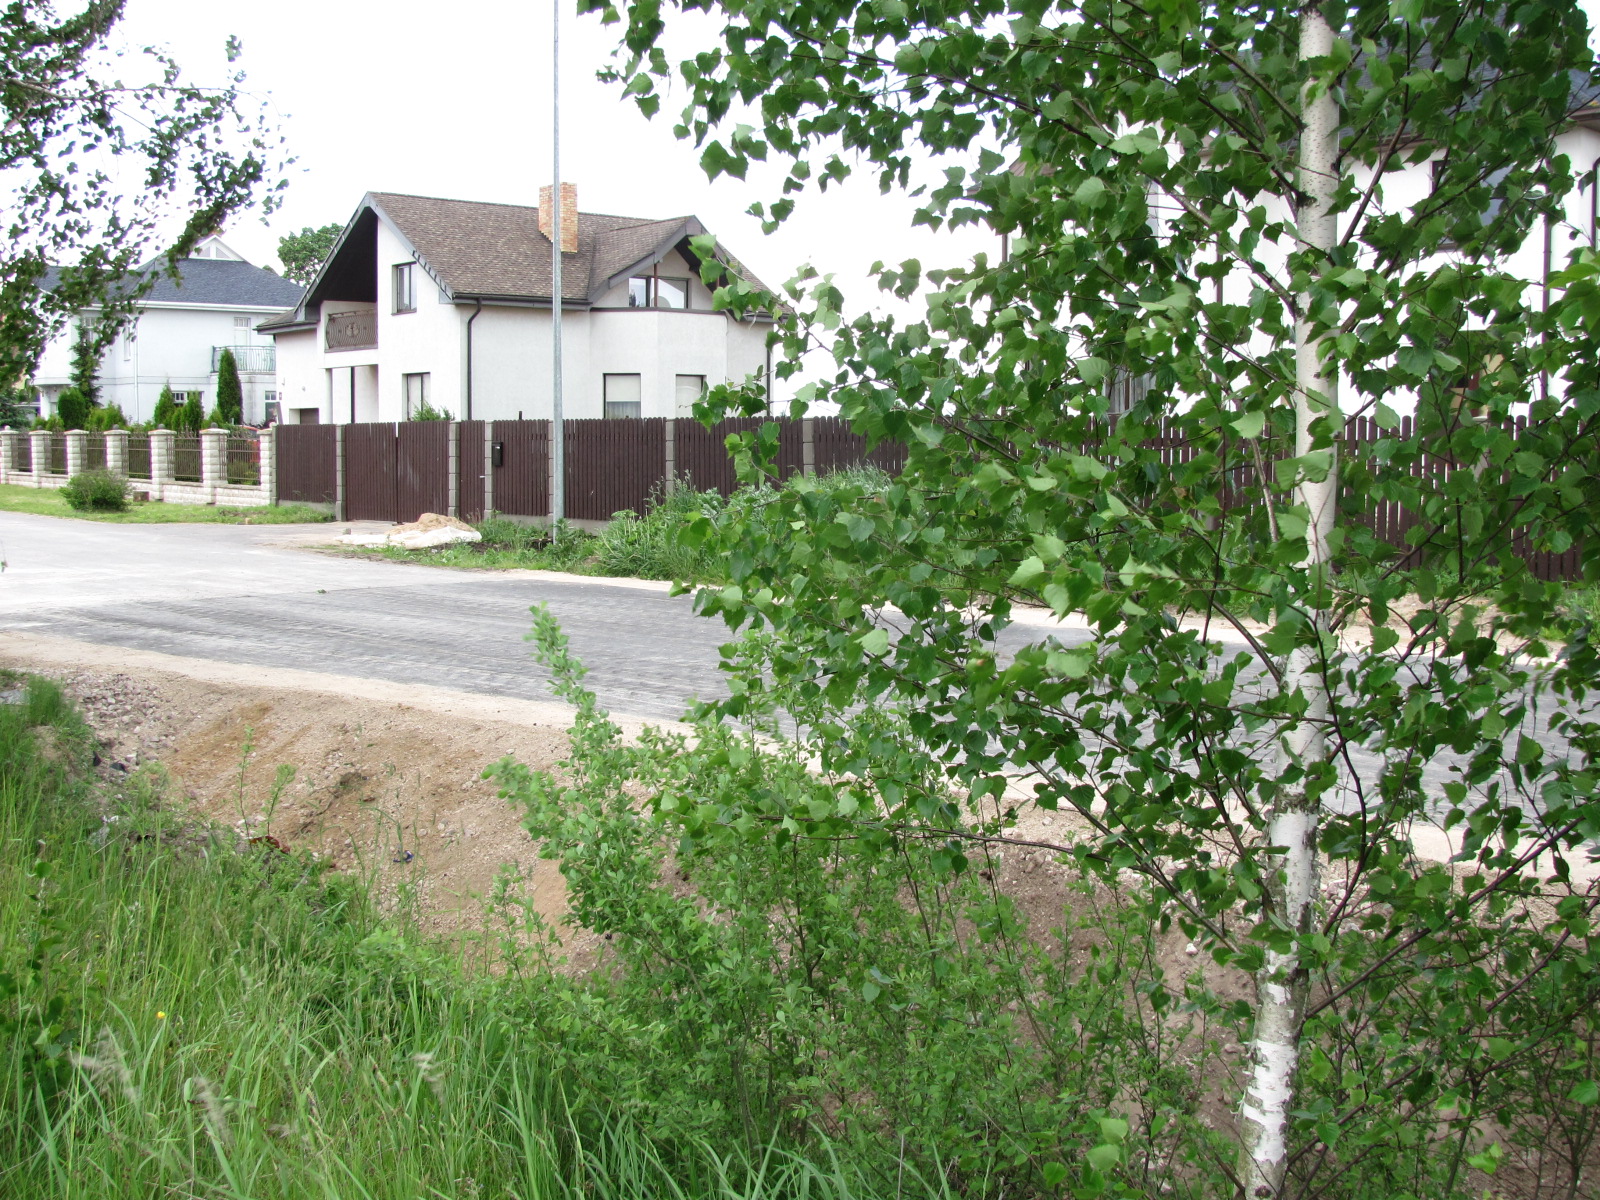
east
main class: Grassland
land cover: Grassland without tree/shrub cover
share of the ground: > 75 %
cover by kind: herbaceous plants 100 %
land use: Residential
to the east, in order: Grassland without tree/shrub cover; Artificial constructions in urban areas
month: June
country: LV
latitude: 56.8060
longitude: 23.9880
